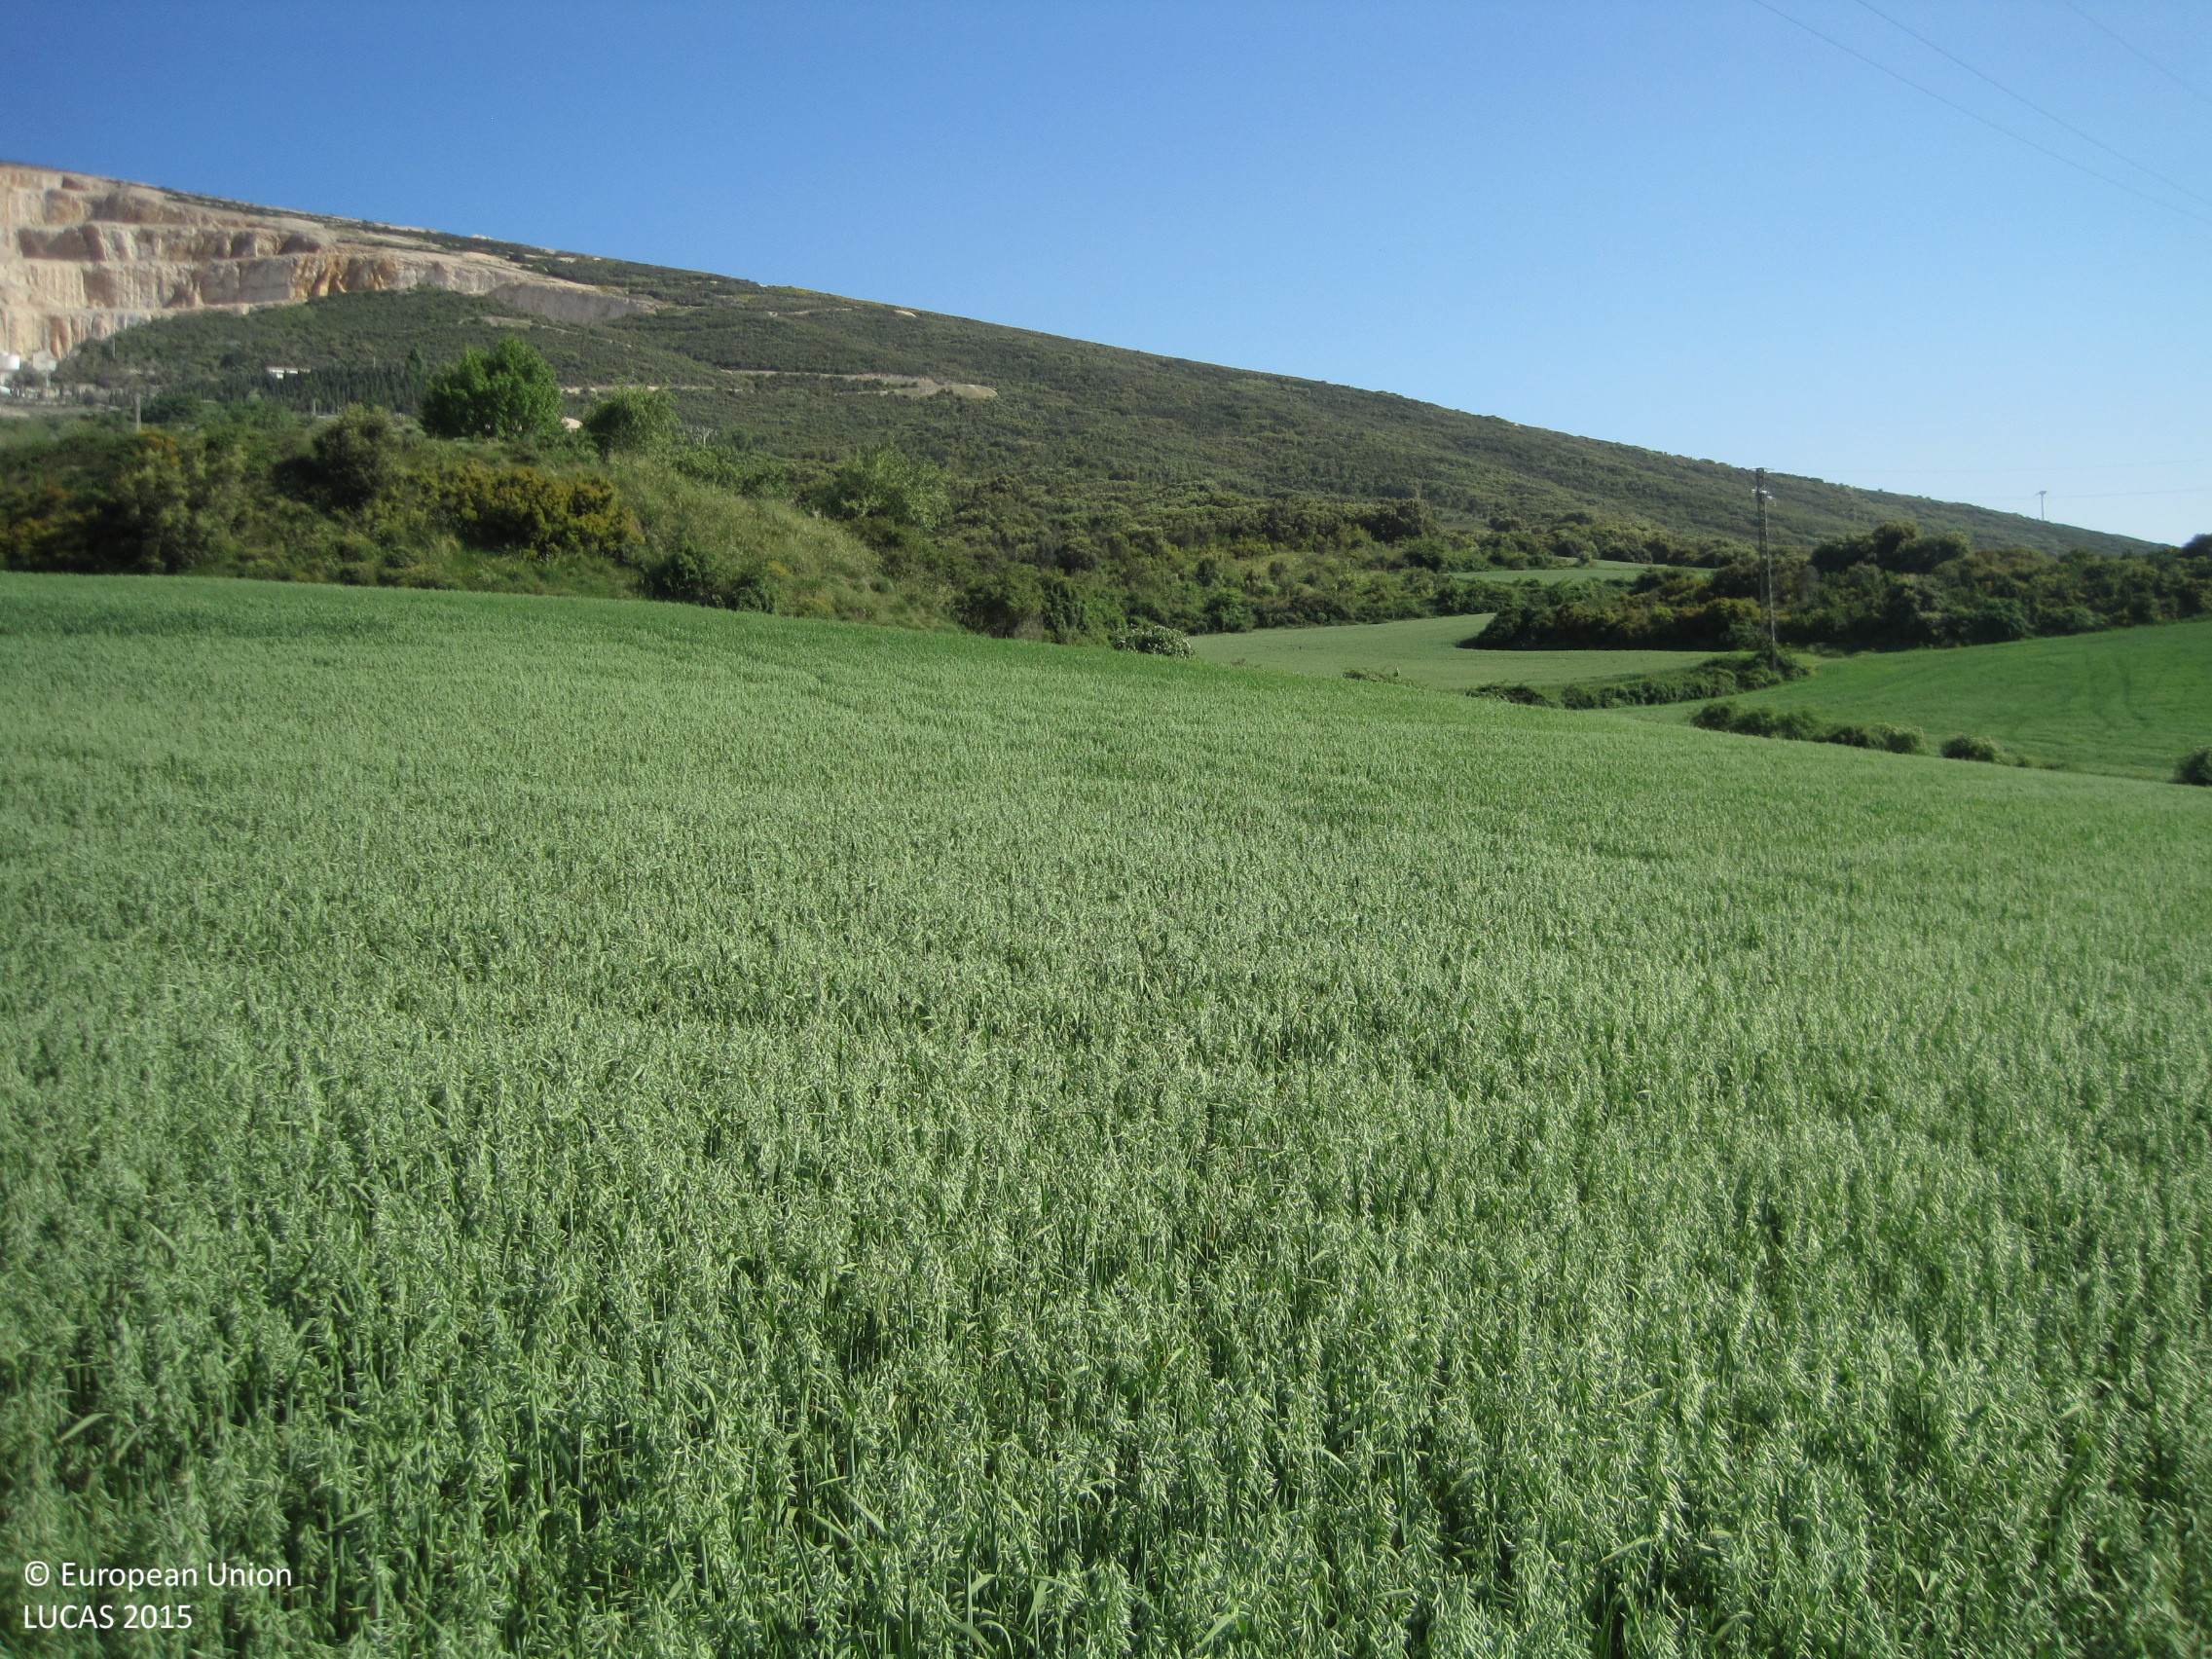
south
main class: Cropland
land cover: Oats
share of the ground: > 75 %
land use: Agriculture (excluding fallow land and kitchen gardens)
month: May
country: ES
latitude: 42.6906
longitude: -1.6456
